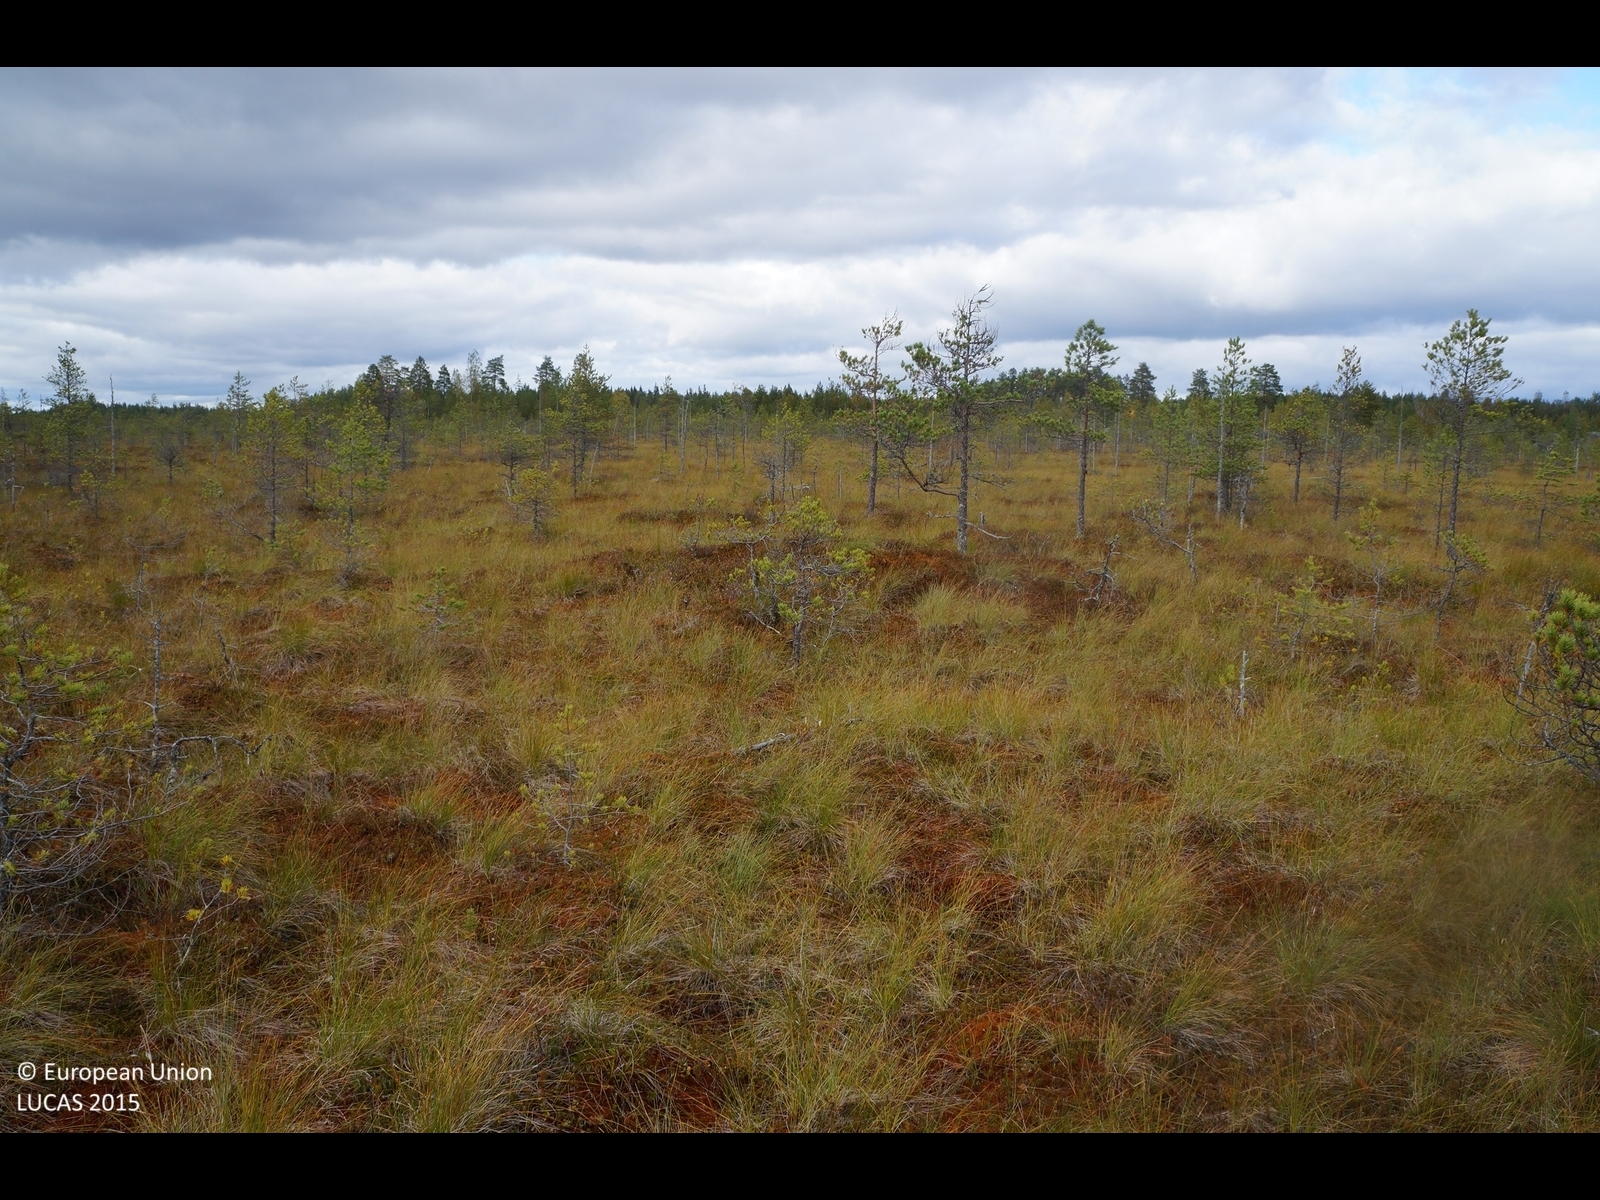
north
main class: Woodland
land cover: Pine dominated coniferous woodland
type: boreal forest
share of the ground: 10 - 25 %
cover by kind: herbaceous plants 40 %, lichens and mosses 30 %, coniferous forest trees 20 %, shrubs 10 %
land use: Semi-natural and natural areas not in use
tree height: < 5 m
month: September
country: FI
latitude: 64.0267
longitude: 24.2522
